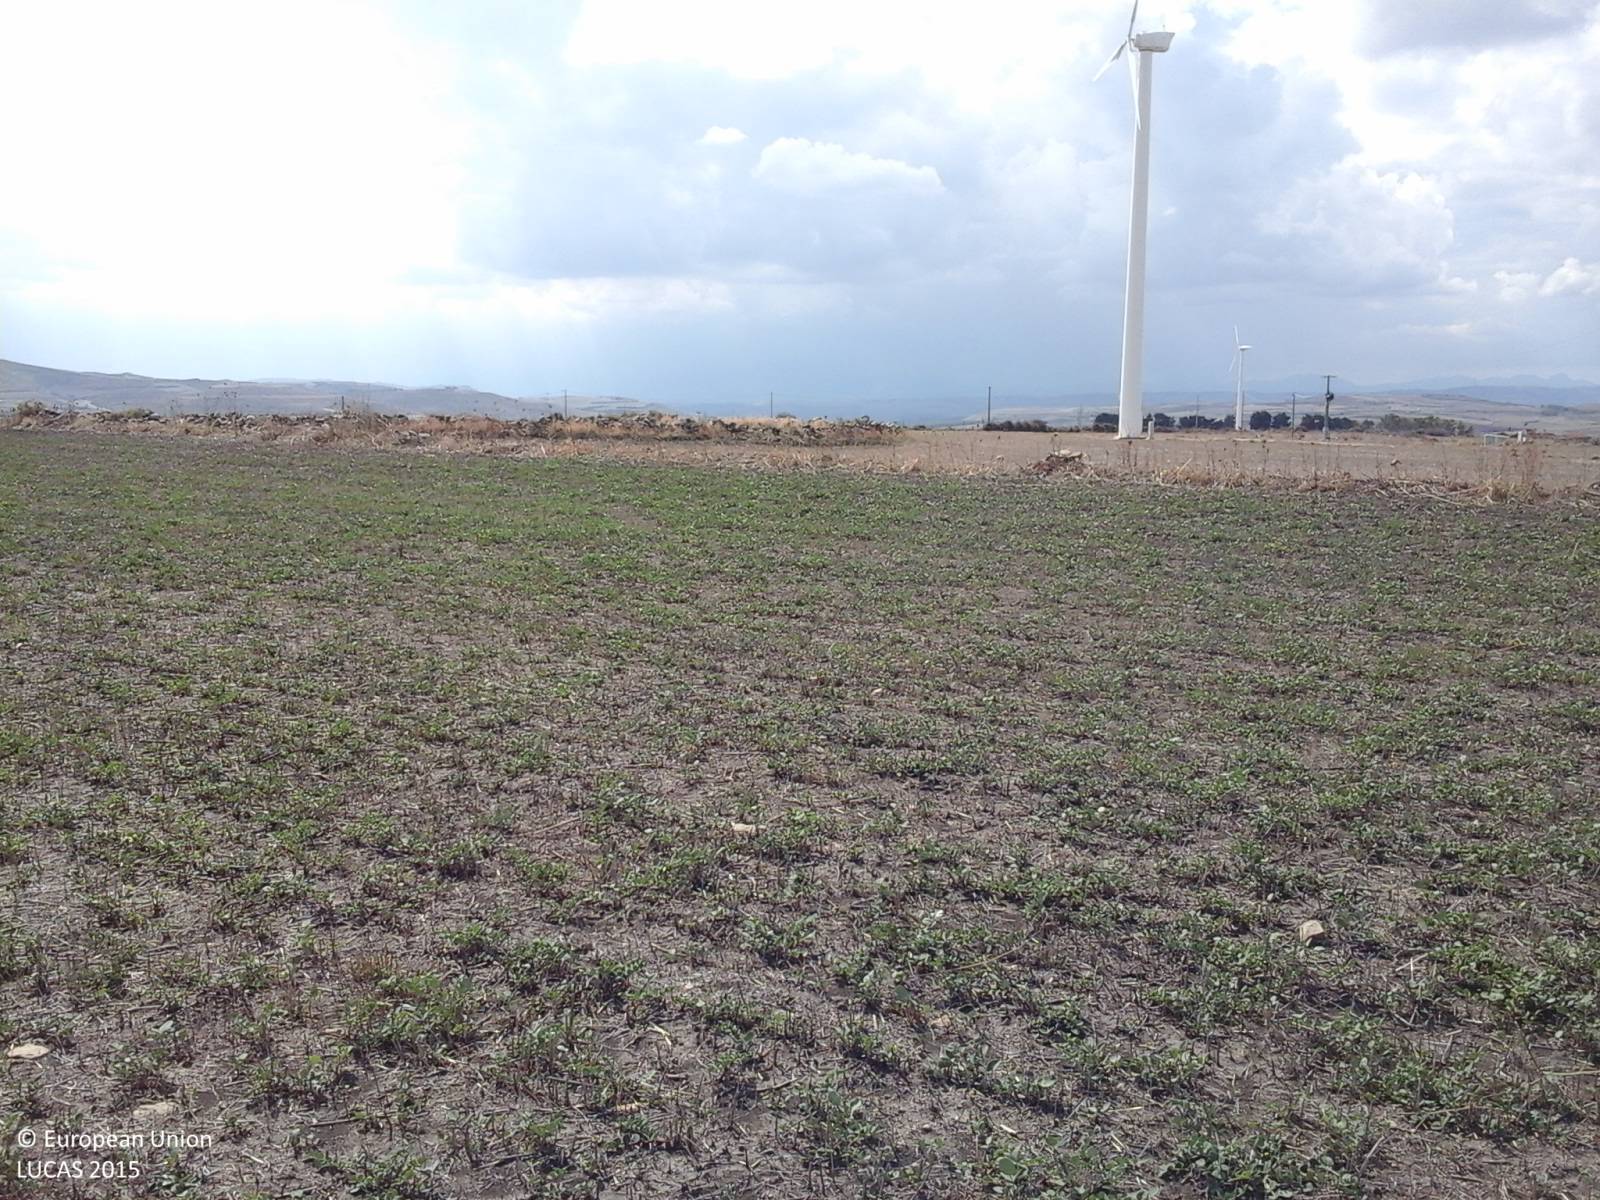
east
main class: Grassland
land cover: Spontaneously vegetated surfaces
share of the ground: > 75 %
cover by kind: herbaceous plants 100 %
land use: Agriculture (excluding fallow land and kitchen gardens)
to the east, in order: Spontaneously vegetated surfaces; Grass margins; Paved roads, cycling and walking lanes; Grass margins; Dry stone walls; Other bare soil; Rock outcrops
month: September
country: IT
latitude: 39.6474
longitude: 9.0847
